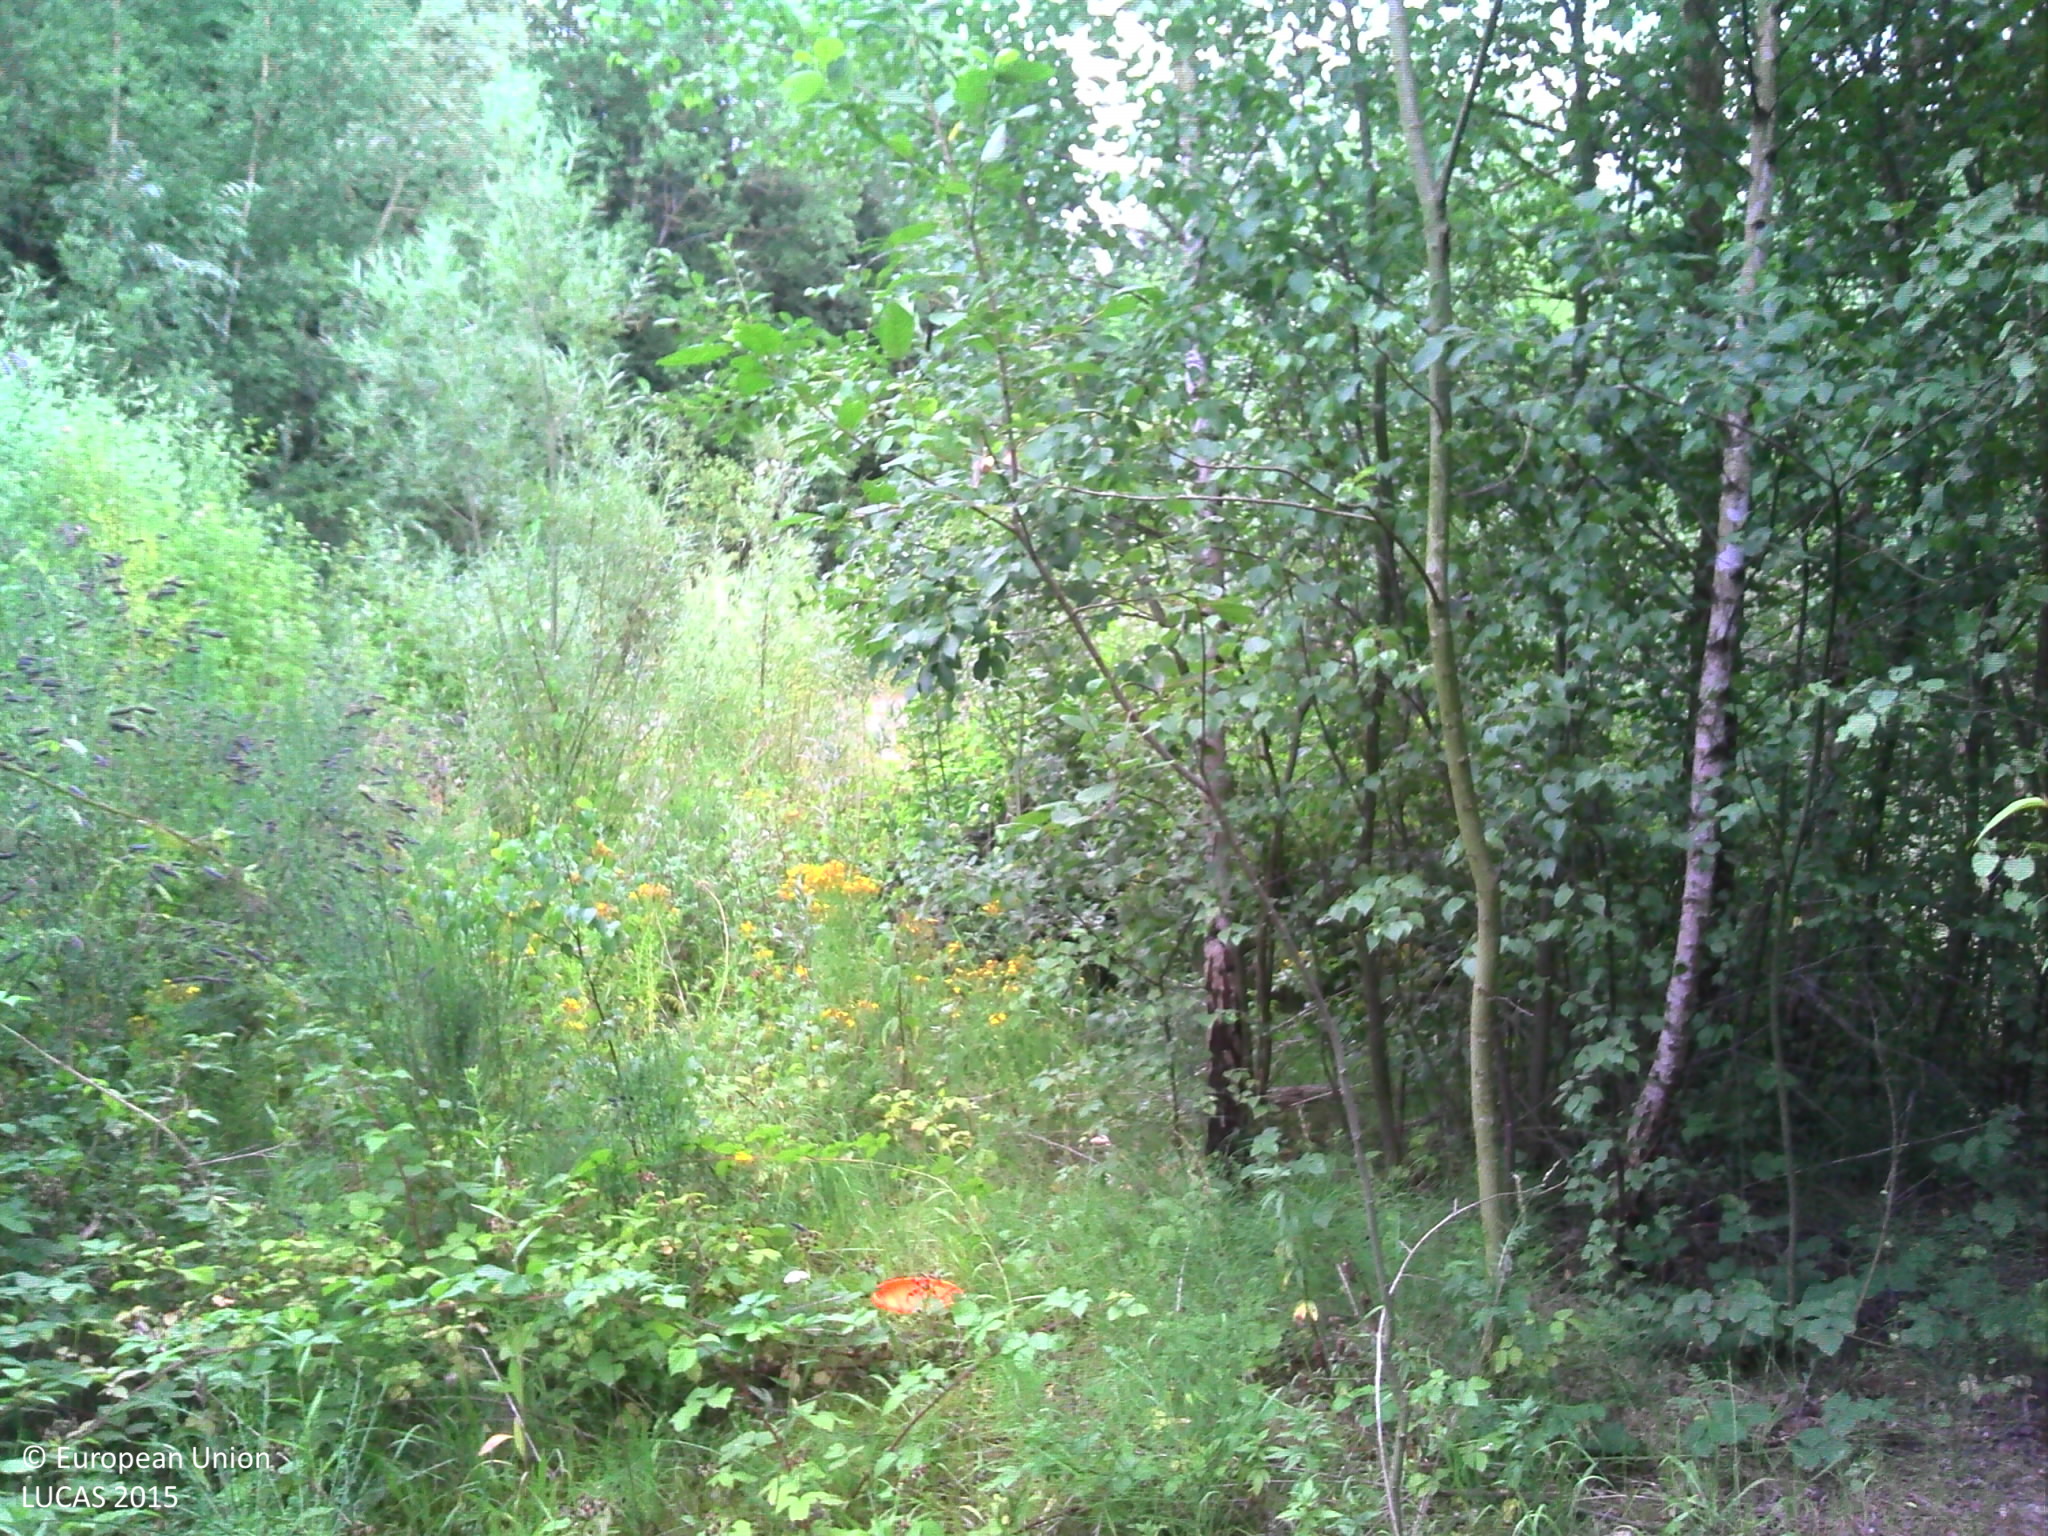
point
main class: Woodland
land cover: Broadleaved woodland
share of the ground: > 75 %
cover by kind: broadleaved forest trees 70 %, herbaceous plants 30 %
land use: Semi-natural and natural areas not in use
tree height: > 5 m
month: July
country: BE
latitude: 50.5591
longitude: 4.5613
